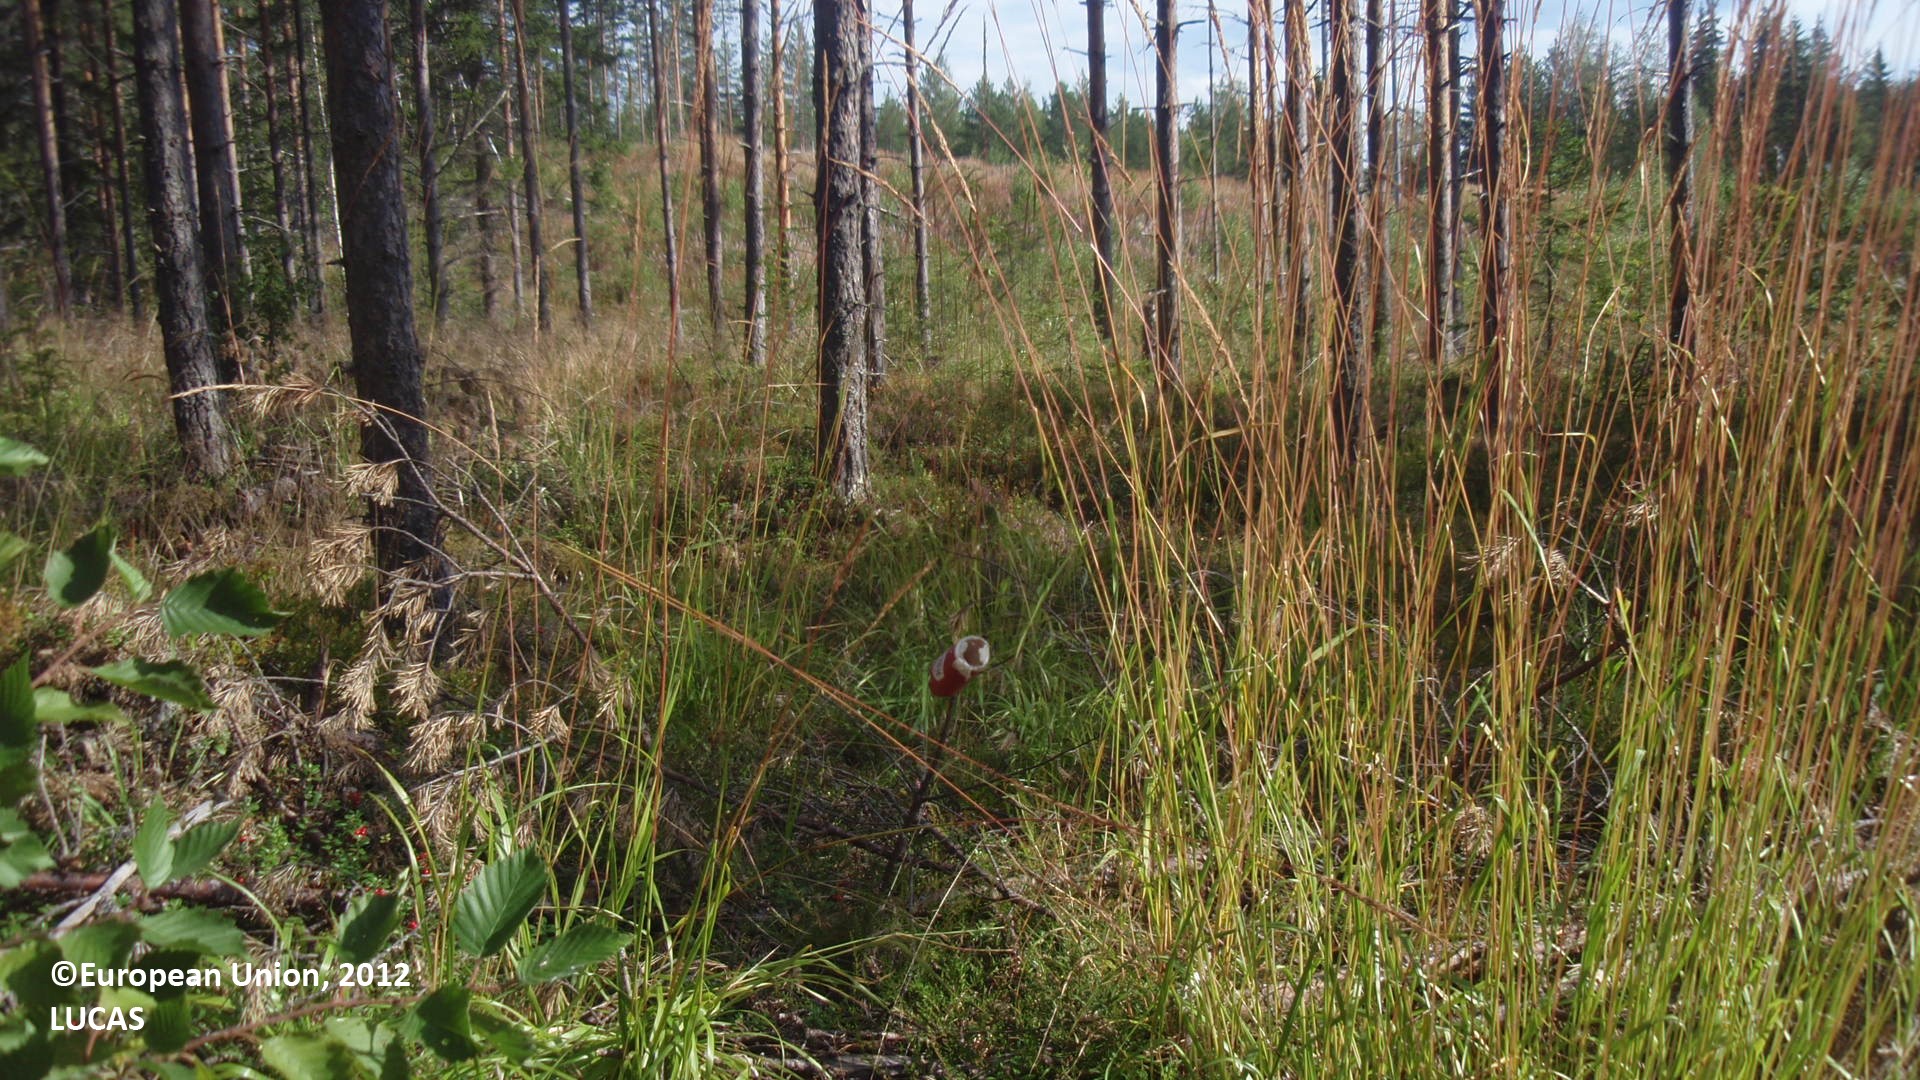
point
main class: Woodland
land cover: Pine dominated coniferous woodland
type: boreal forest
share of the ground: 50 - 75 %
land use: Forestry
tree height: > 5 m
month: August
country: FI
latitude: 61.3635
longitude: 27.2485
